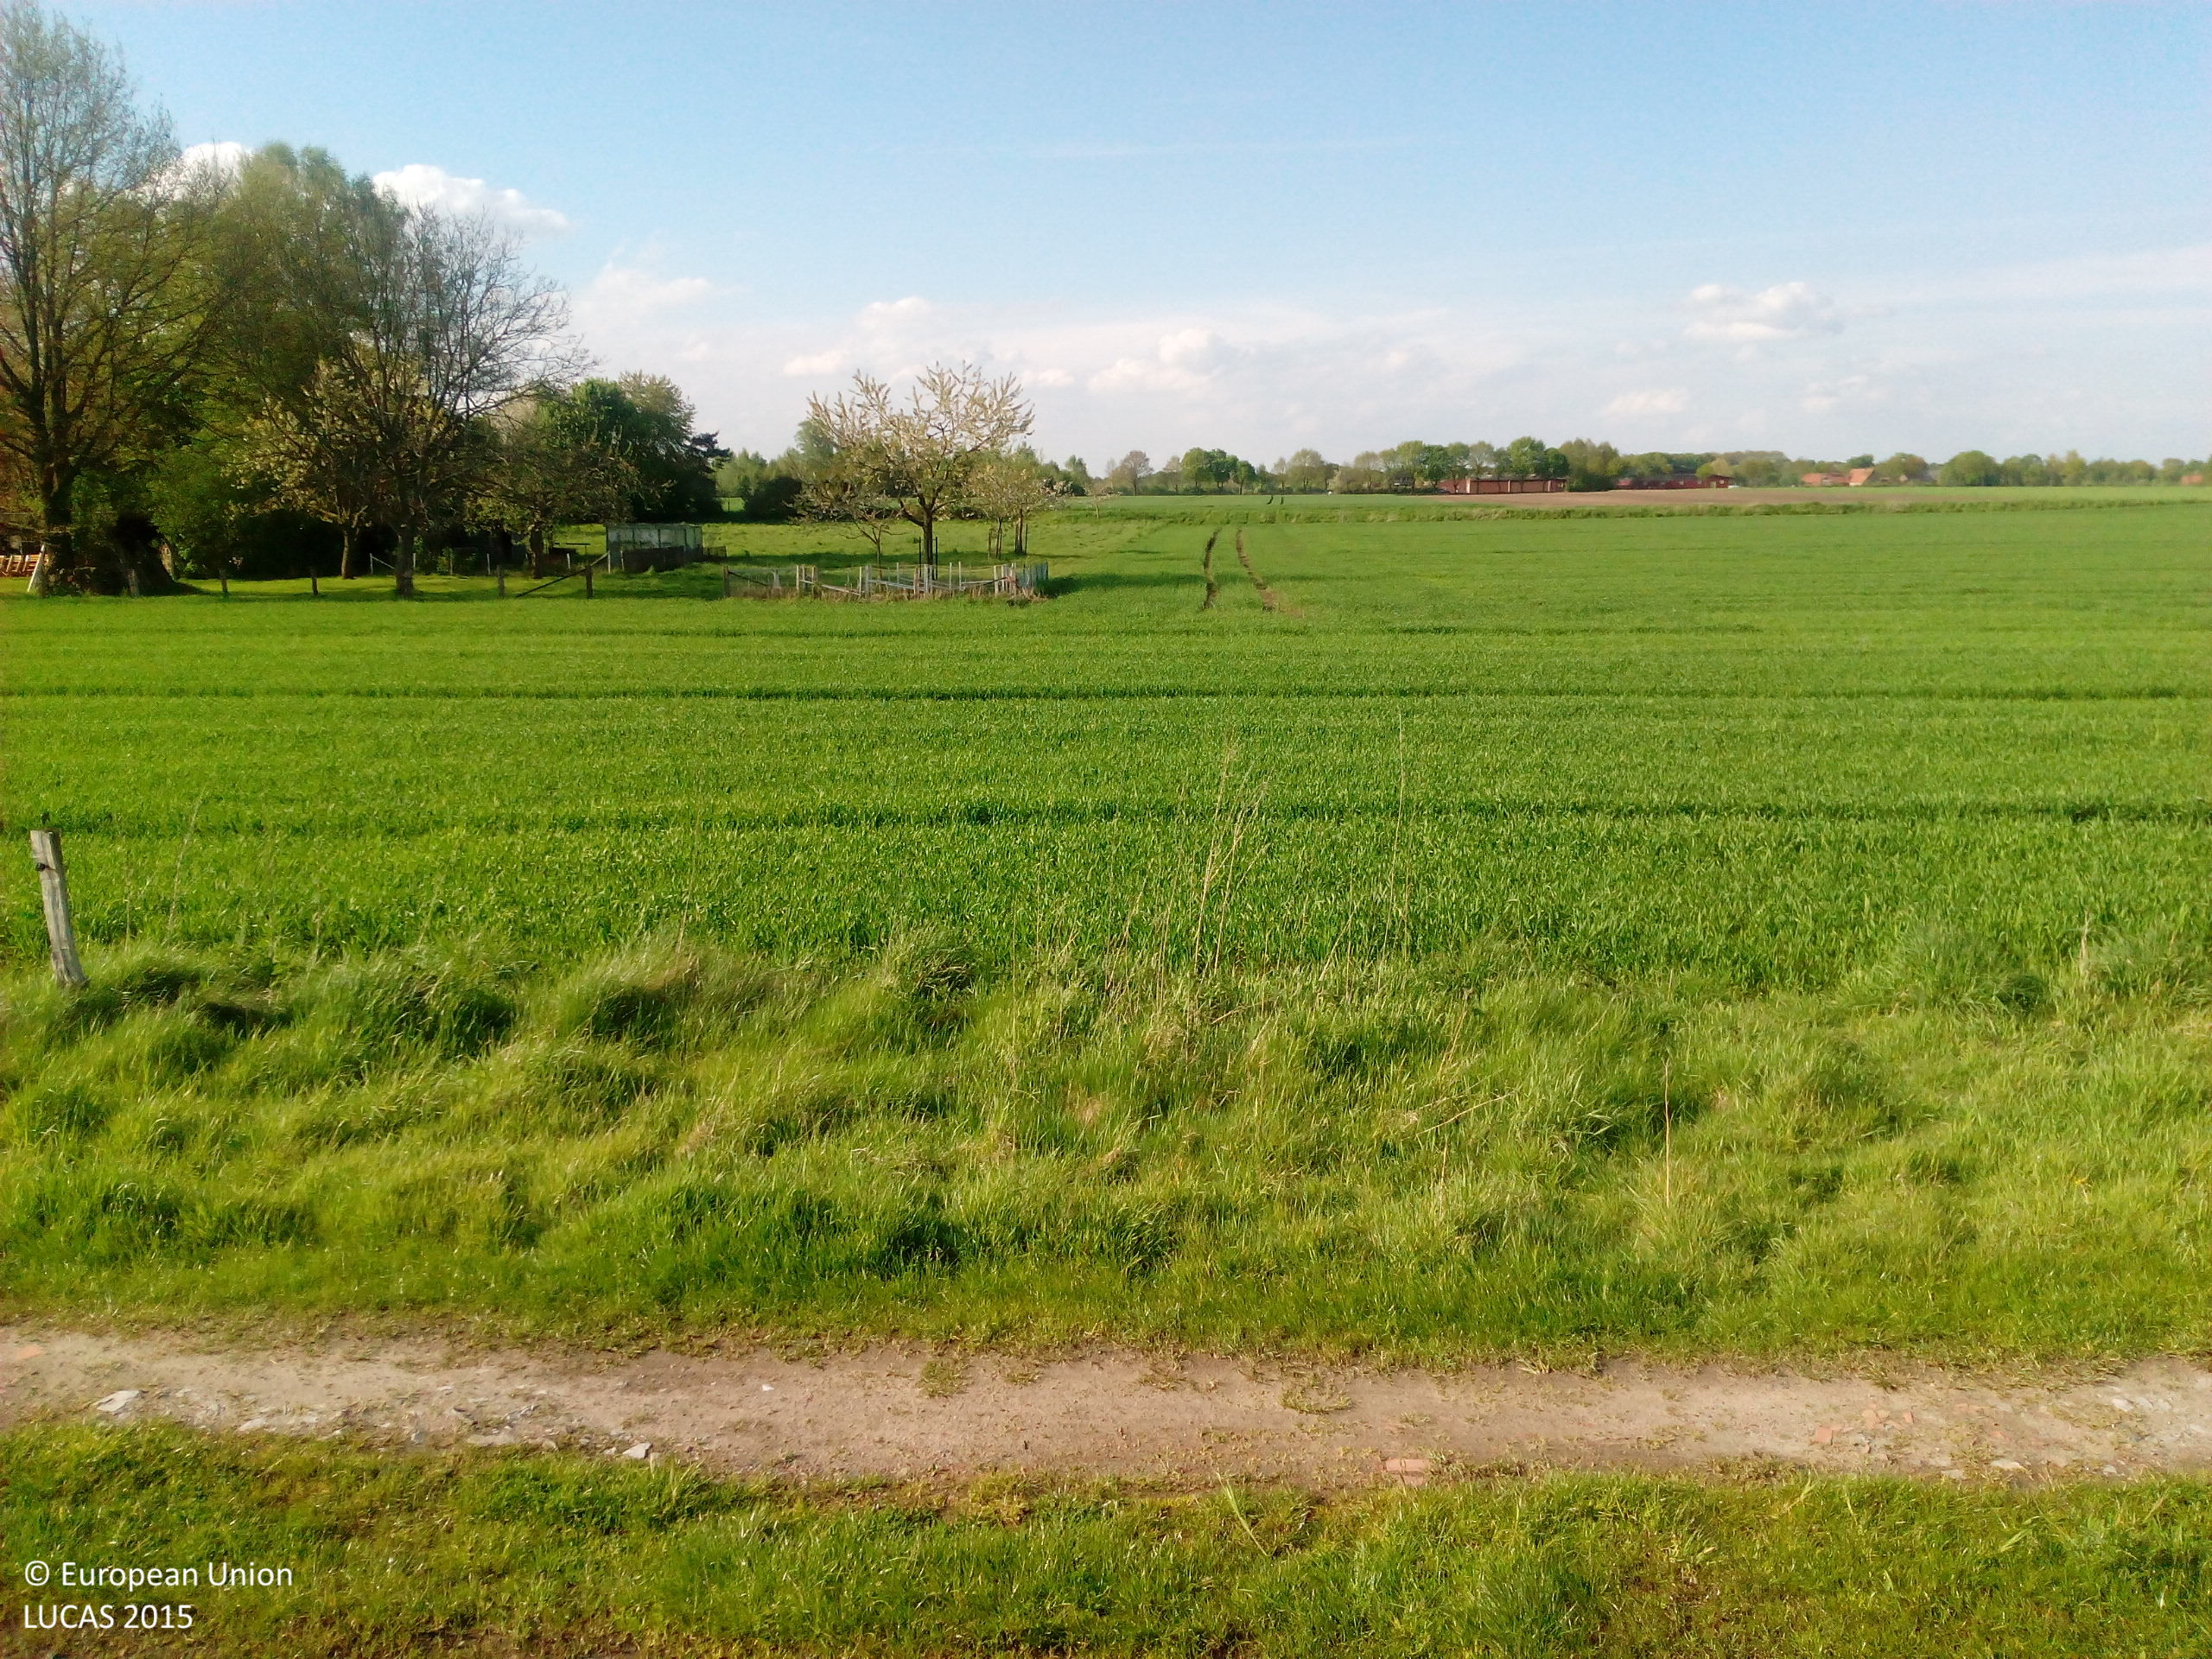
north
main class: Grassland
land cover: Grassland without tree/shrub cover
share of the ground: > 75 %
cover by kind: herbaceous plants 100 %
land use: Agriculture (excluding fallow land and kitchen gardens)
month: May
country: DE
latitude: 51.7390
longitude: 7.4660
